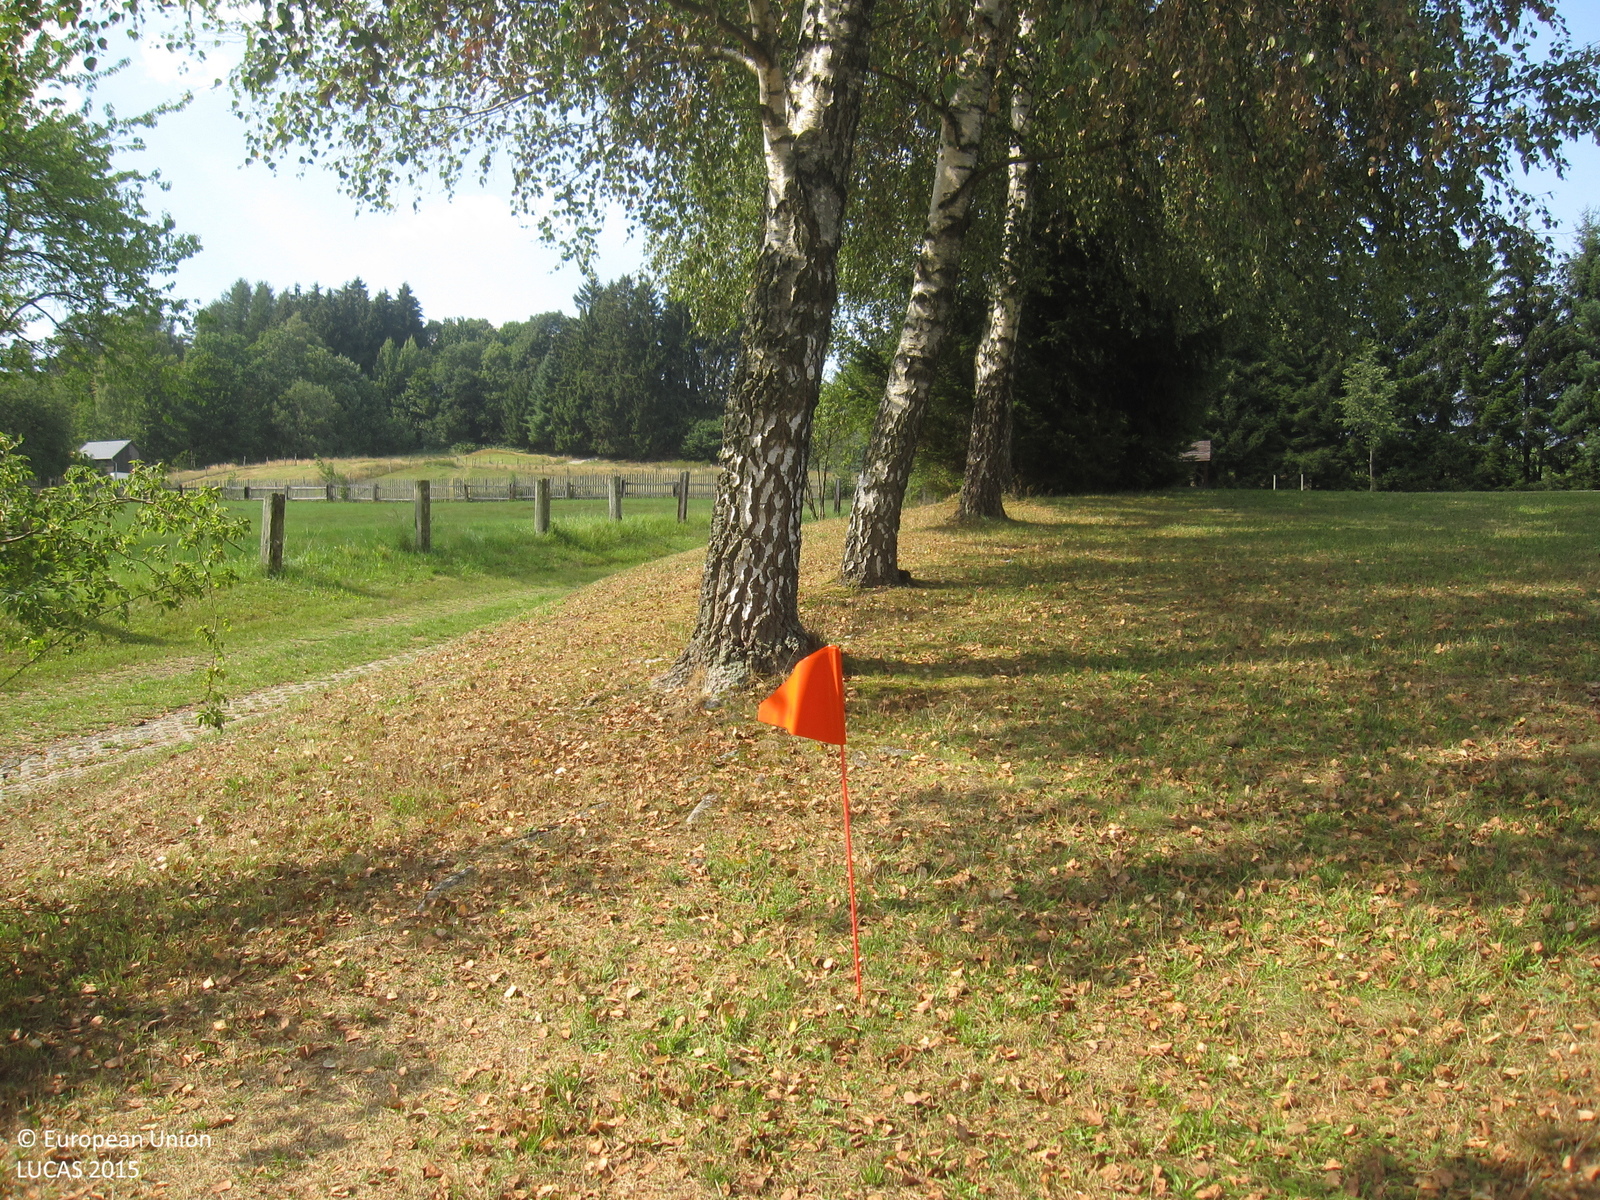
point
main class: Grassland
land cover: Grassland with sparse tree/shrub cover
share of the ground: > 75 %
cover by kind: herbaceous plants 90 %, broadleaved forest trees 5 %, consolidated bare surface 5 %
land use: Amenities, museums, leisure
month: August
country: DE
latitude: 50.4609
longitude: 11.5914
